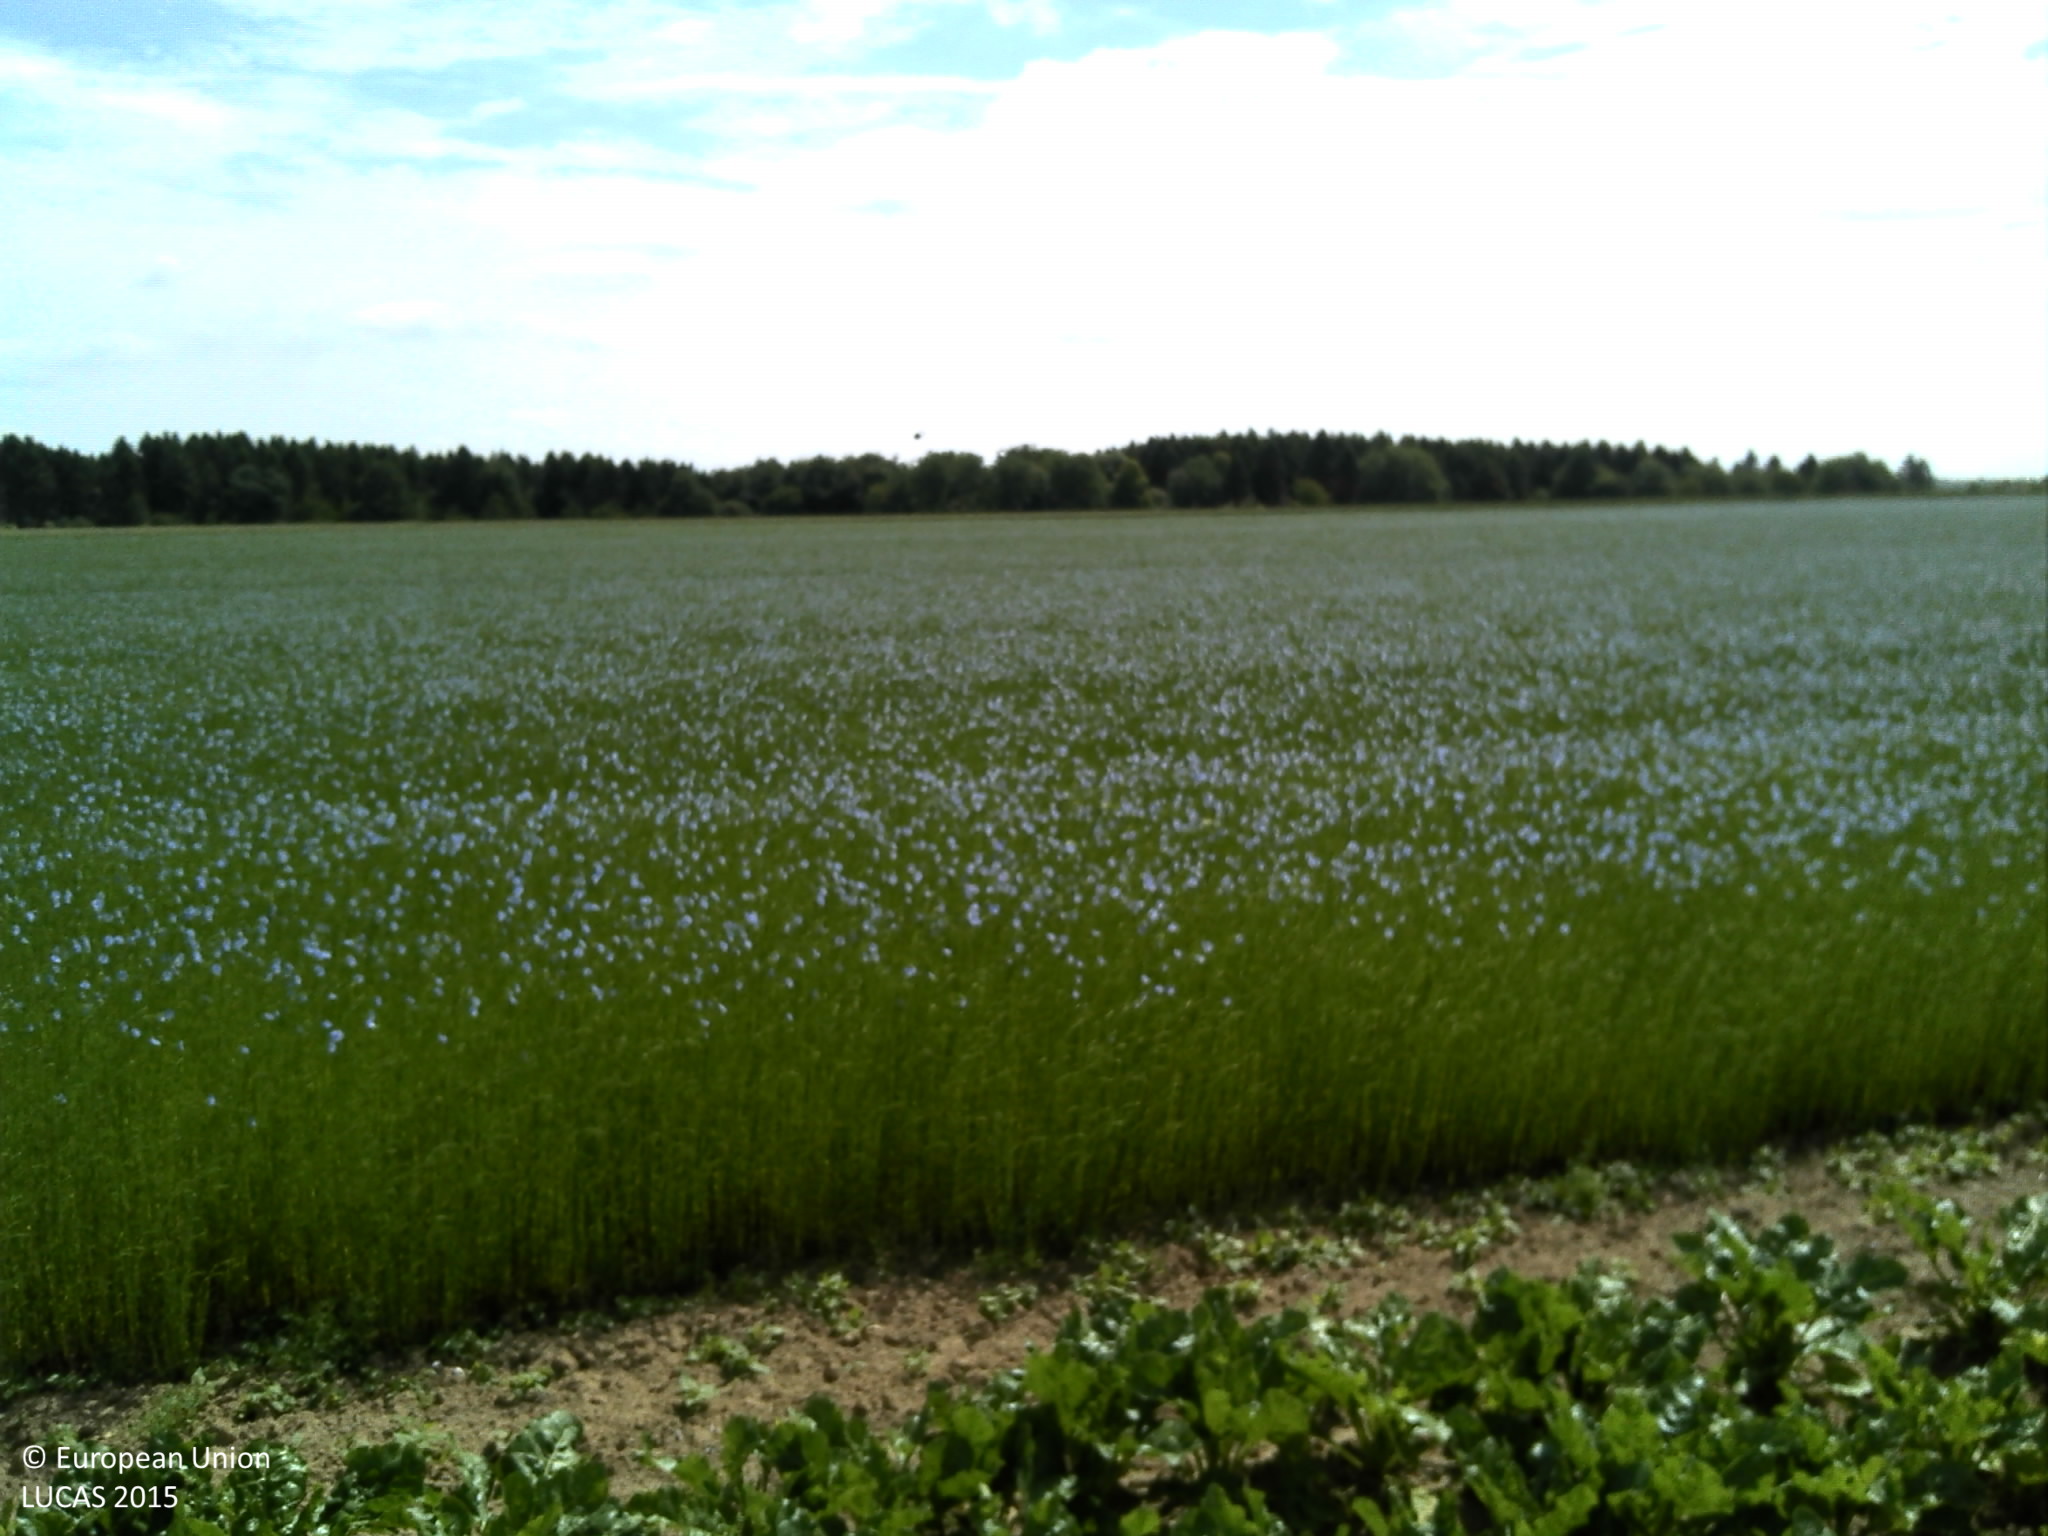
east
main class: Cropland
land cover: Sugar beet
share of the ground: > 75 %
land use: Agriculture (excluding fallow land and kitchen gardens)
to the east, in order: Sugar beet; Other fibre and oleaginous crops; Grassland without tree/shrub cover; Common wheat
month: June
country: FR
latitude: 49.8038
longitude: 1.1556
